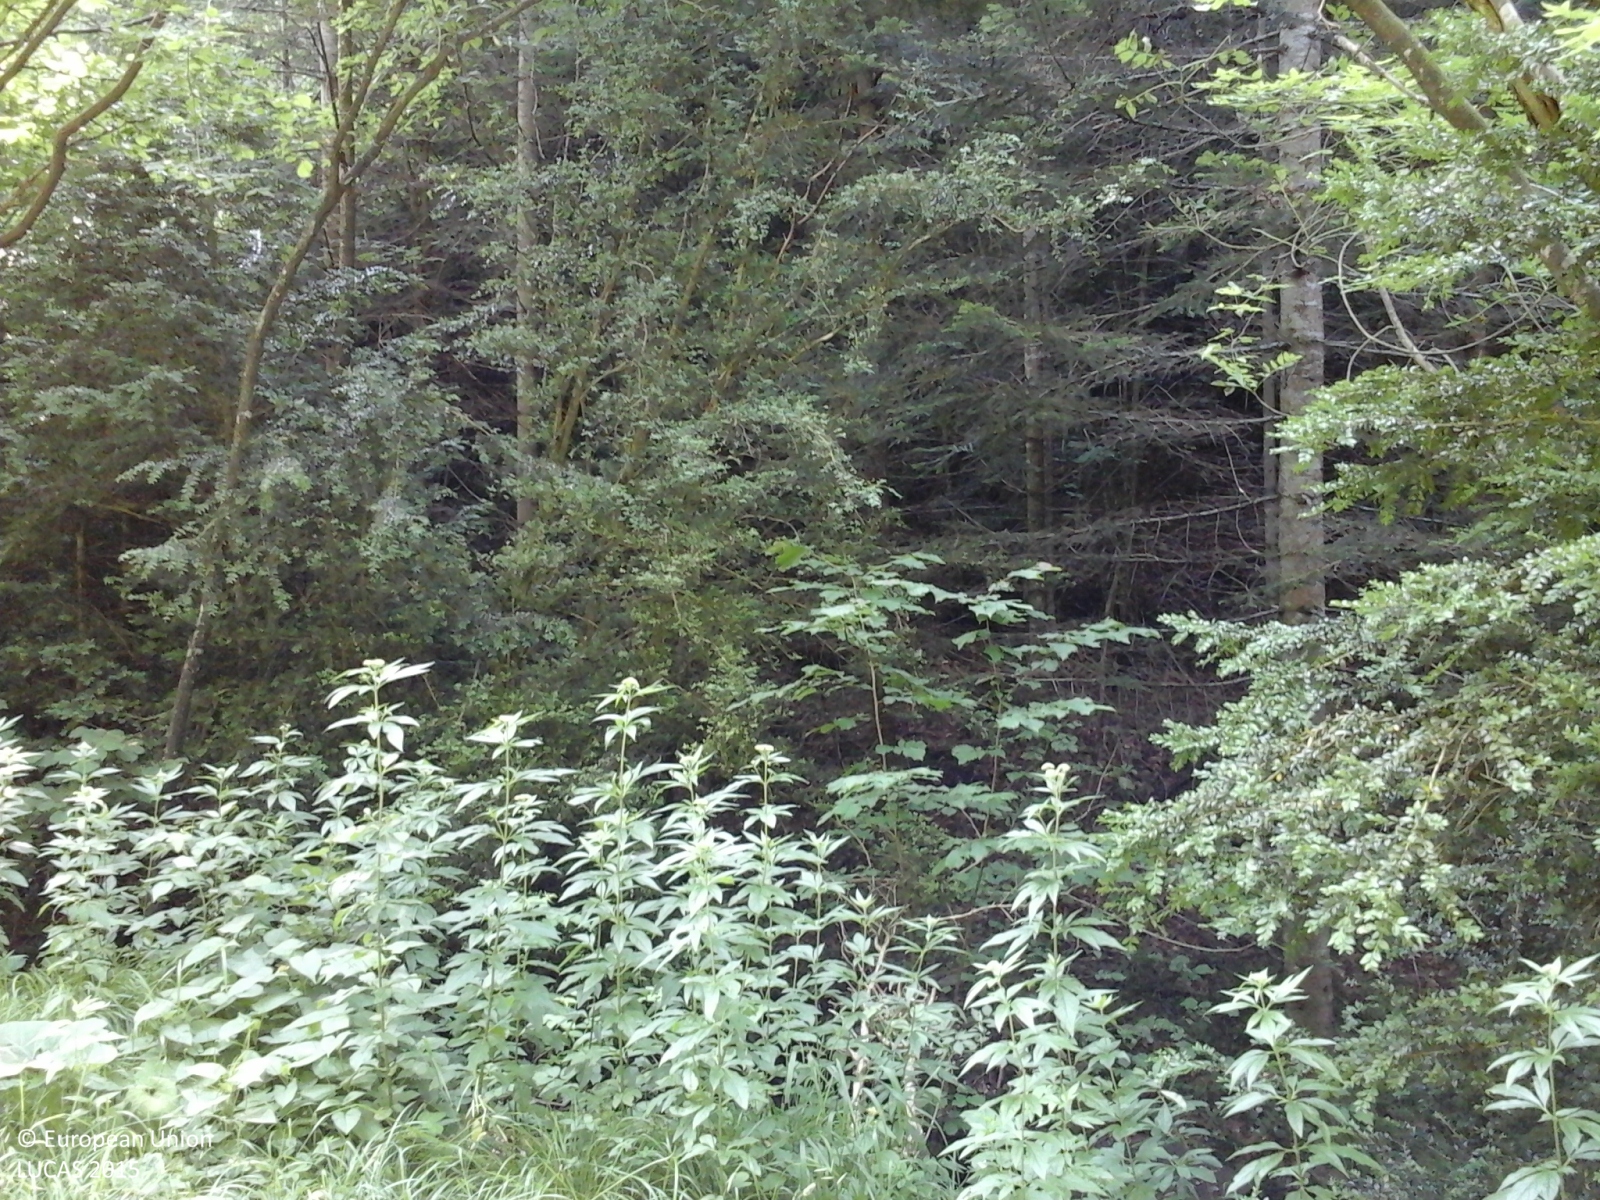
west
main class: Woodland
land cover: Other mixed woodland
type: mountainous beech forest
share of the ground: > 75 %
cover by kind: broadleaved forest trees 70 %, coniferous forest trees 30 %
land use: Semi-natural and natural areas not in use
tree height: > 5 m
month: July
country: IT
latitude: 44.4586
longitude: 7.2531
